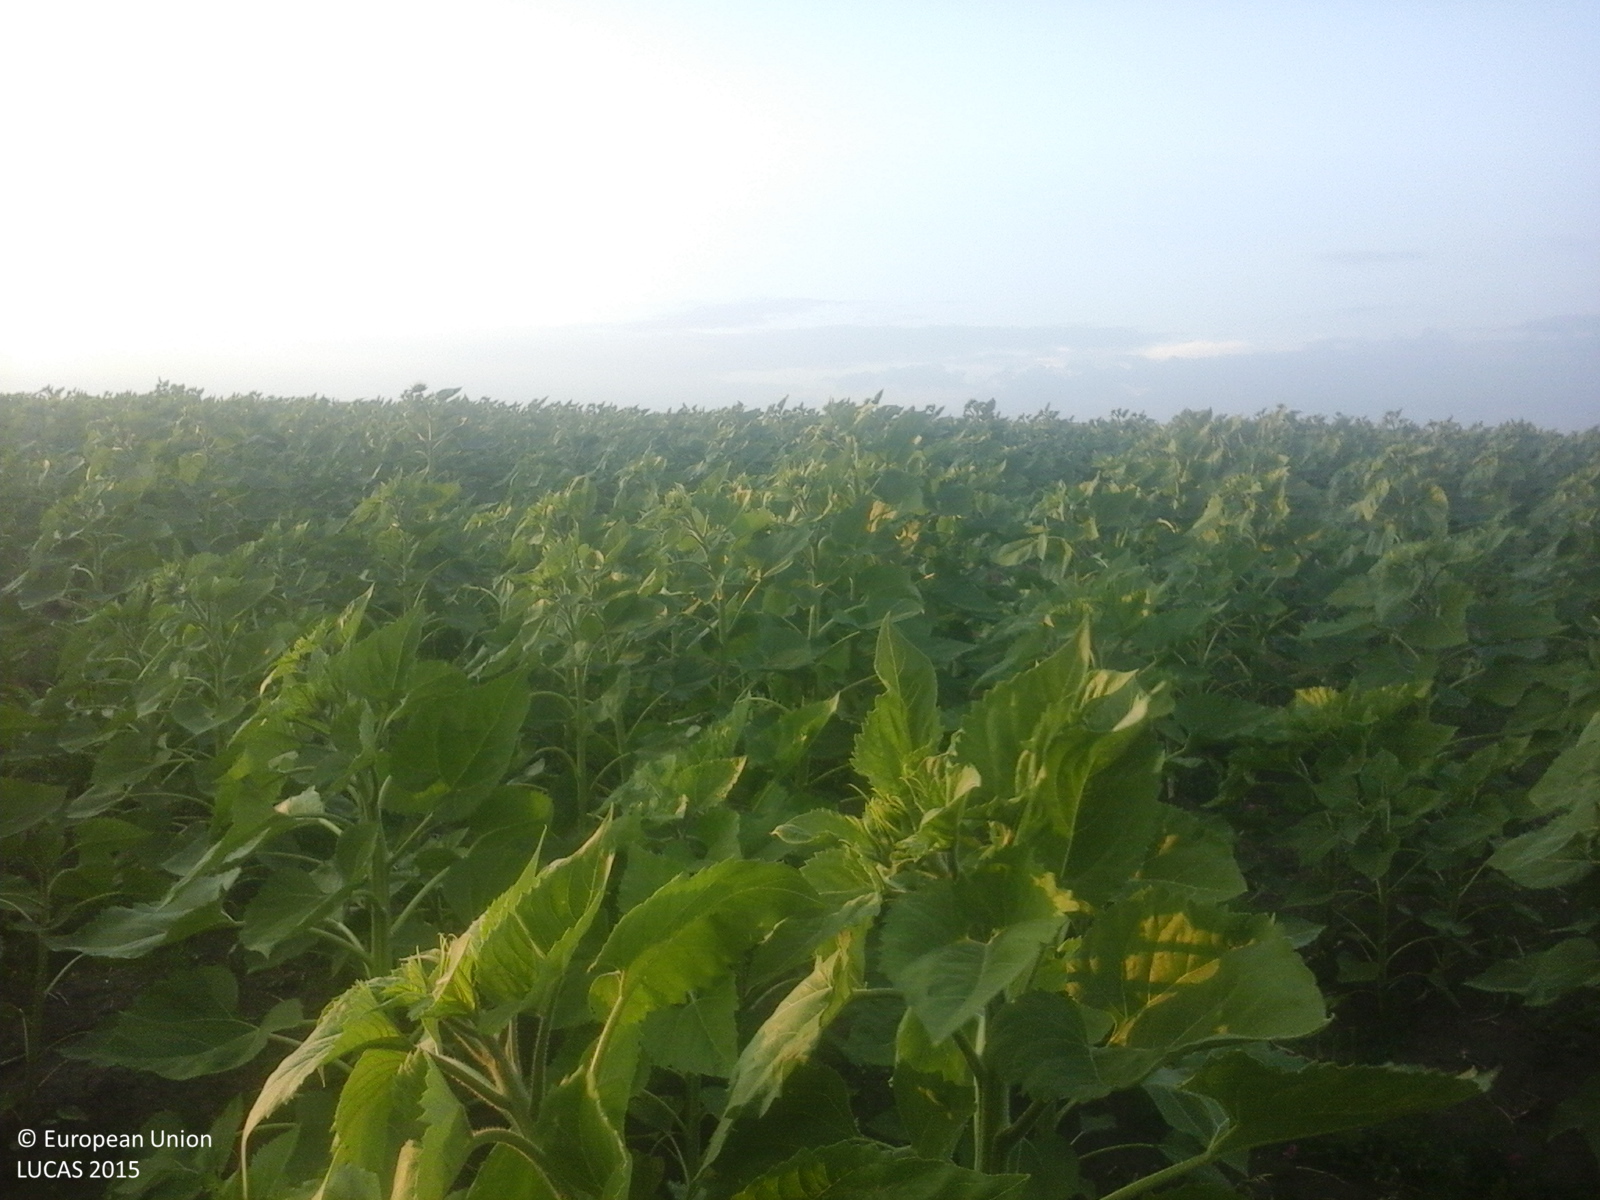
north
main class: Cropland
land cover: Sunflower
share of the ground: > 75 %
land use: Agriculture (excluding fallow land and kitchen gardens)
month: June
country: RO
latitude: 46.7876
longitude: 27.7391
